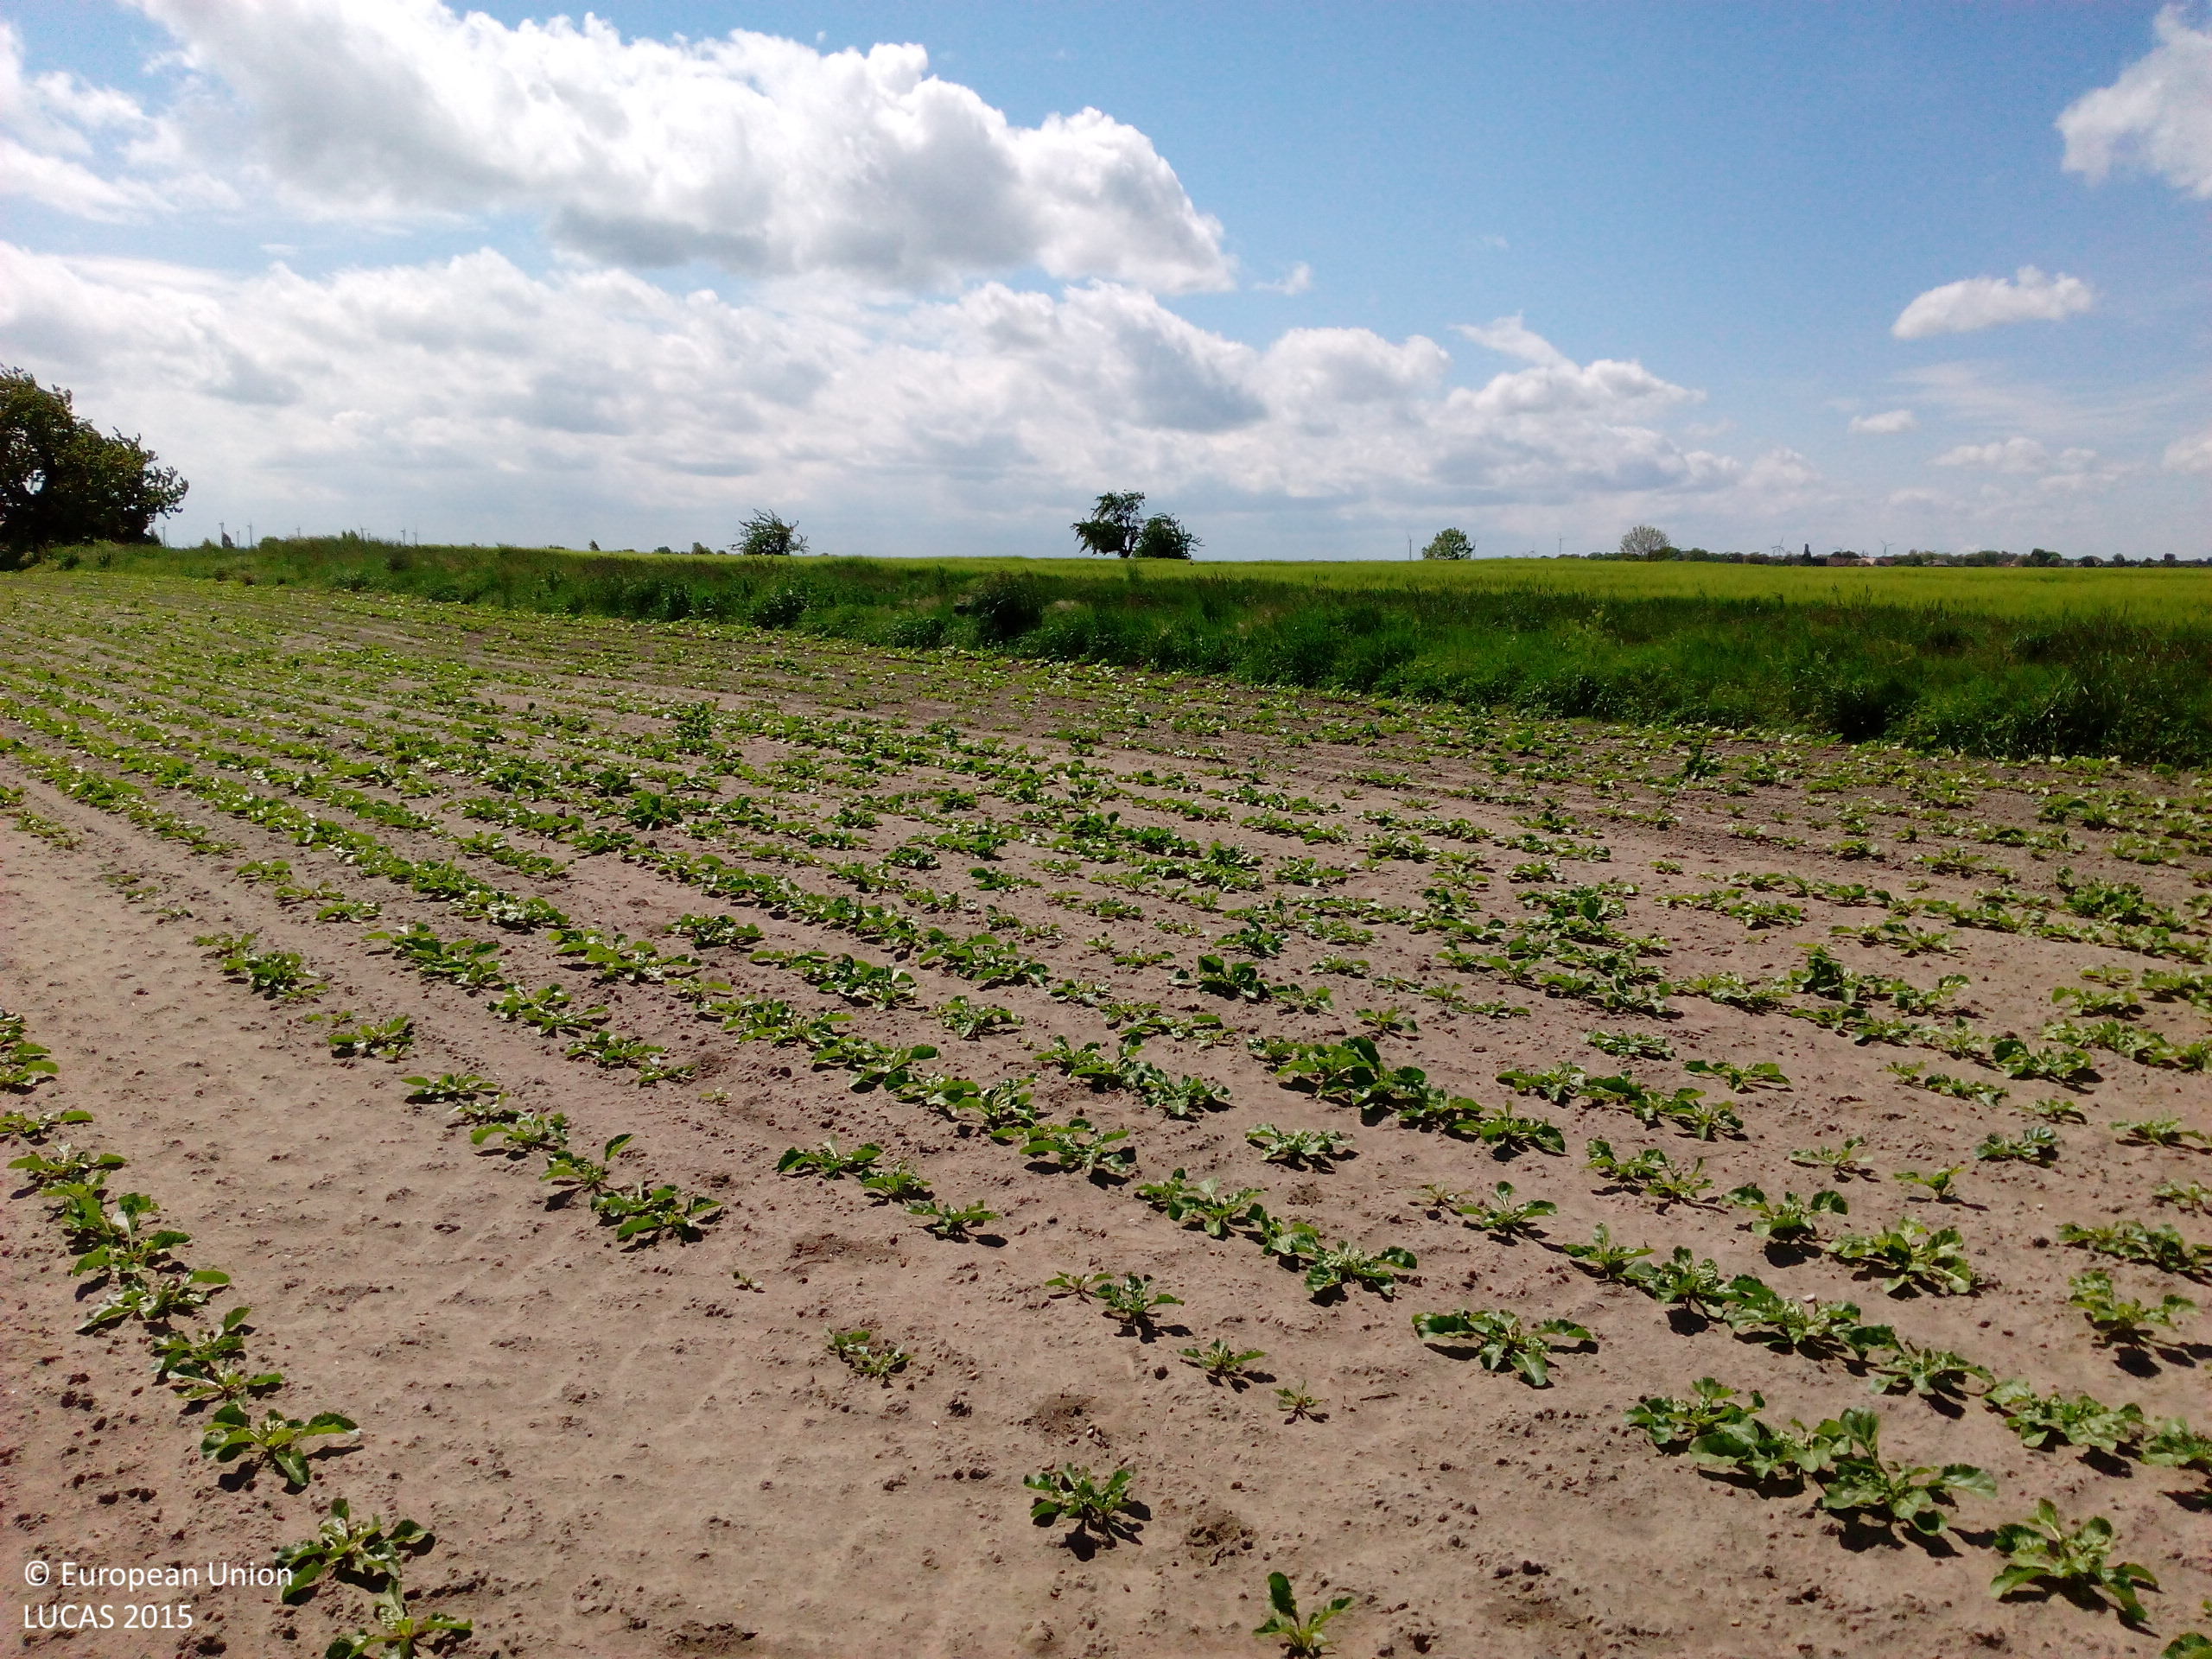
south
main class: Cropland
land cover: Sugar beet
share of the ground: 50 - 75 %
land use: Agriculture (excluding fallow land and kitchen gardens)
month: May
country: DE
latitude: 51.6197
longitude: 12.2095
